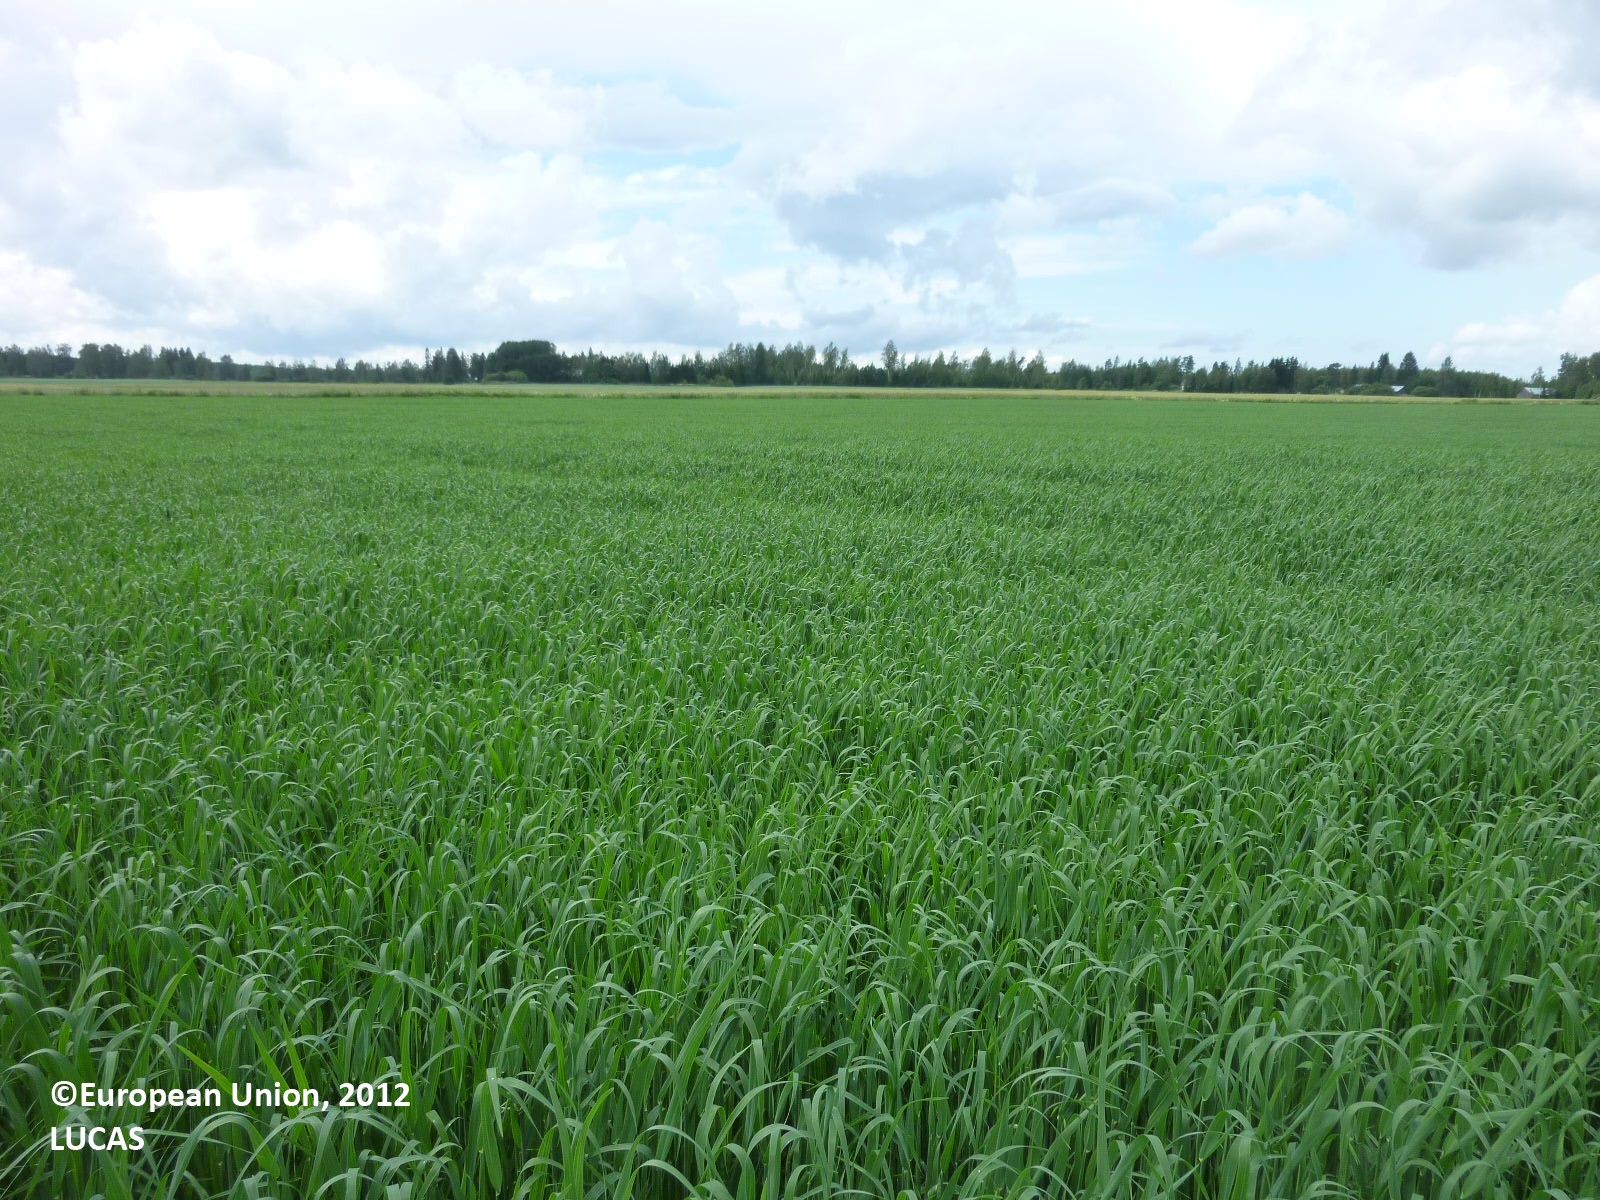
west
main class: Cropland
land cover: Oats
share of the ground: > 75 %
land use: Agriculture (excluding fallow land and kitchen gardens)
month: July
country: FI
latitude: 61.2325
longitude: 22.0361
